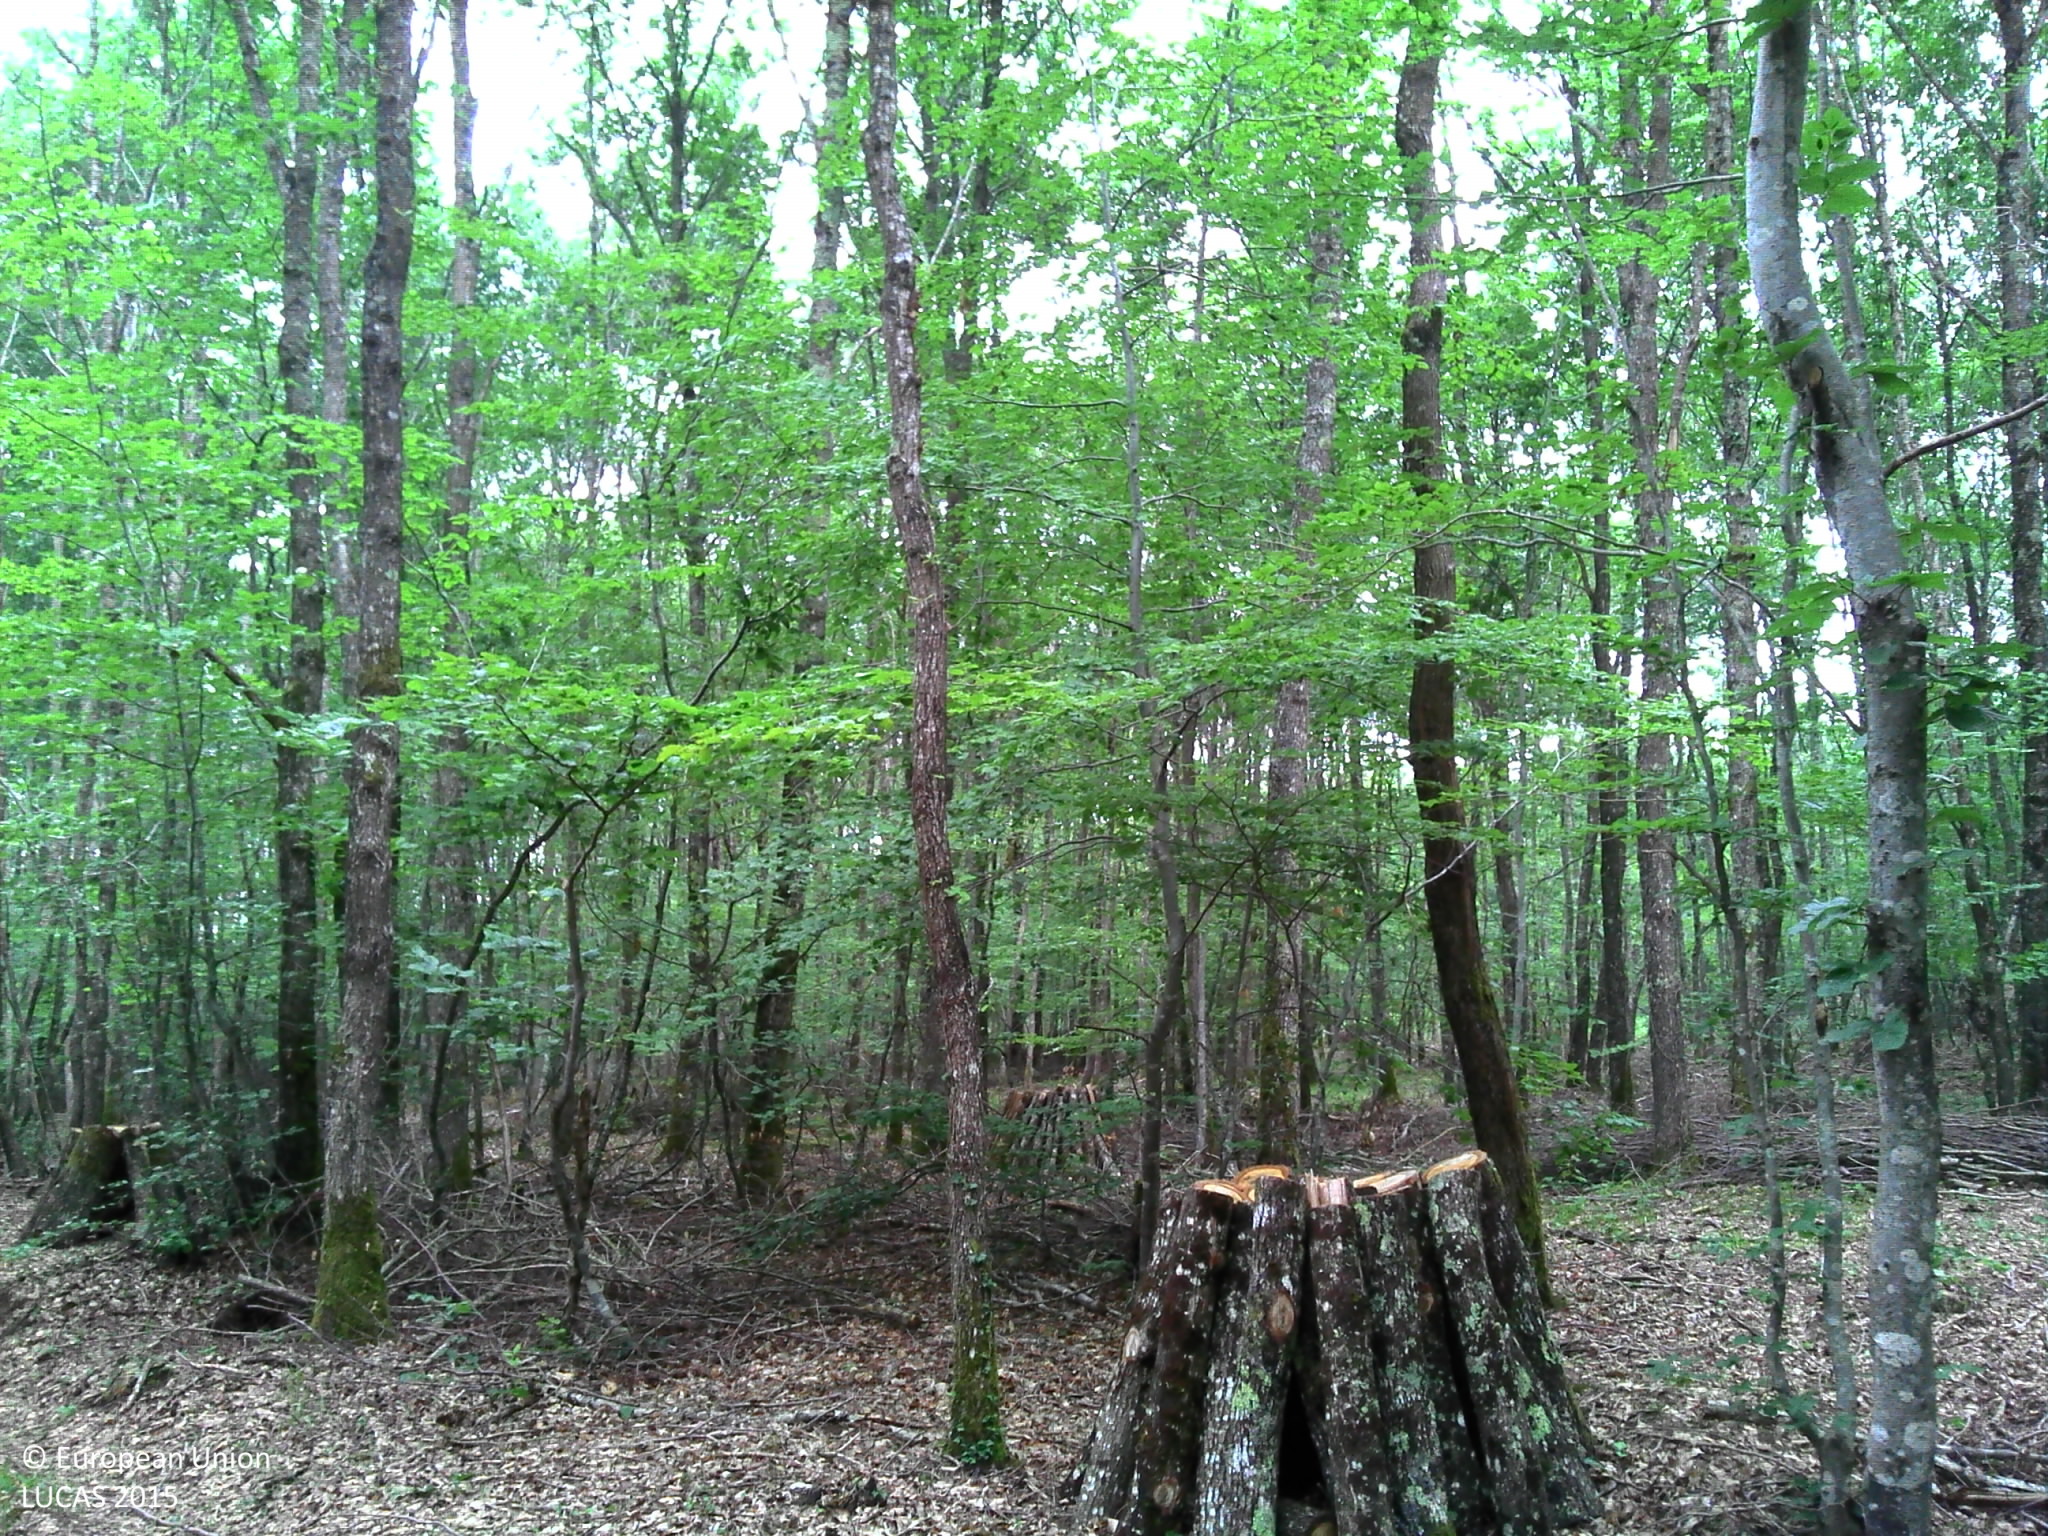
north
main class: Woodland
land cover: Broadleaved woodland
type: beech forest
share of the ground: > 75 %
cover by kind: broadleaved forest trees 90 %, herbaceous plants 5 %, unconsolidated bare surface 5 %
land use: Forestry
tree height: > 5 m
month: June
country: FR
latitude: 46.6273
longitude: 2.7208
